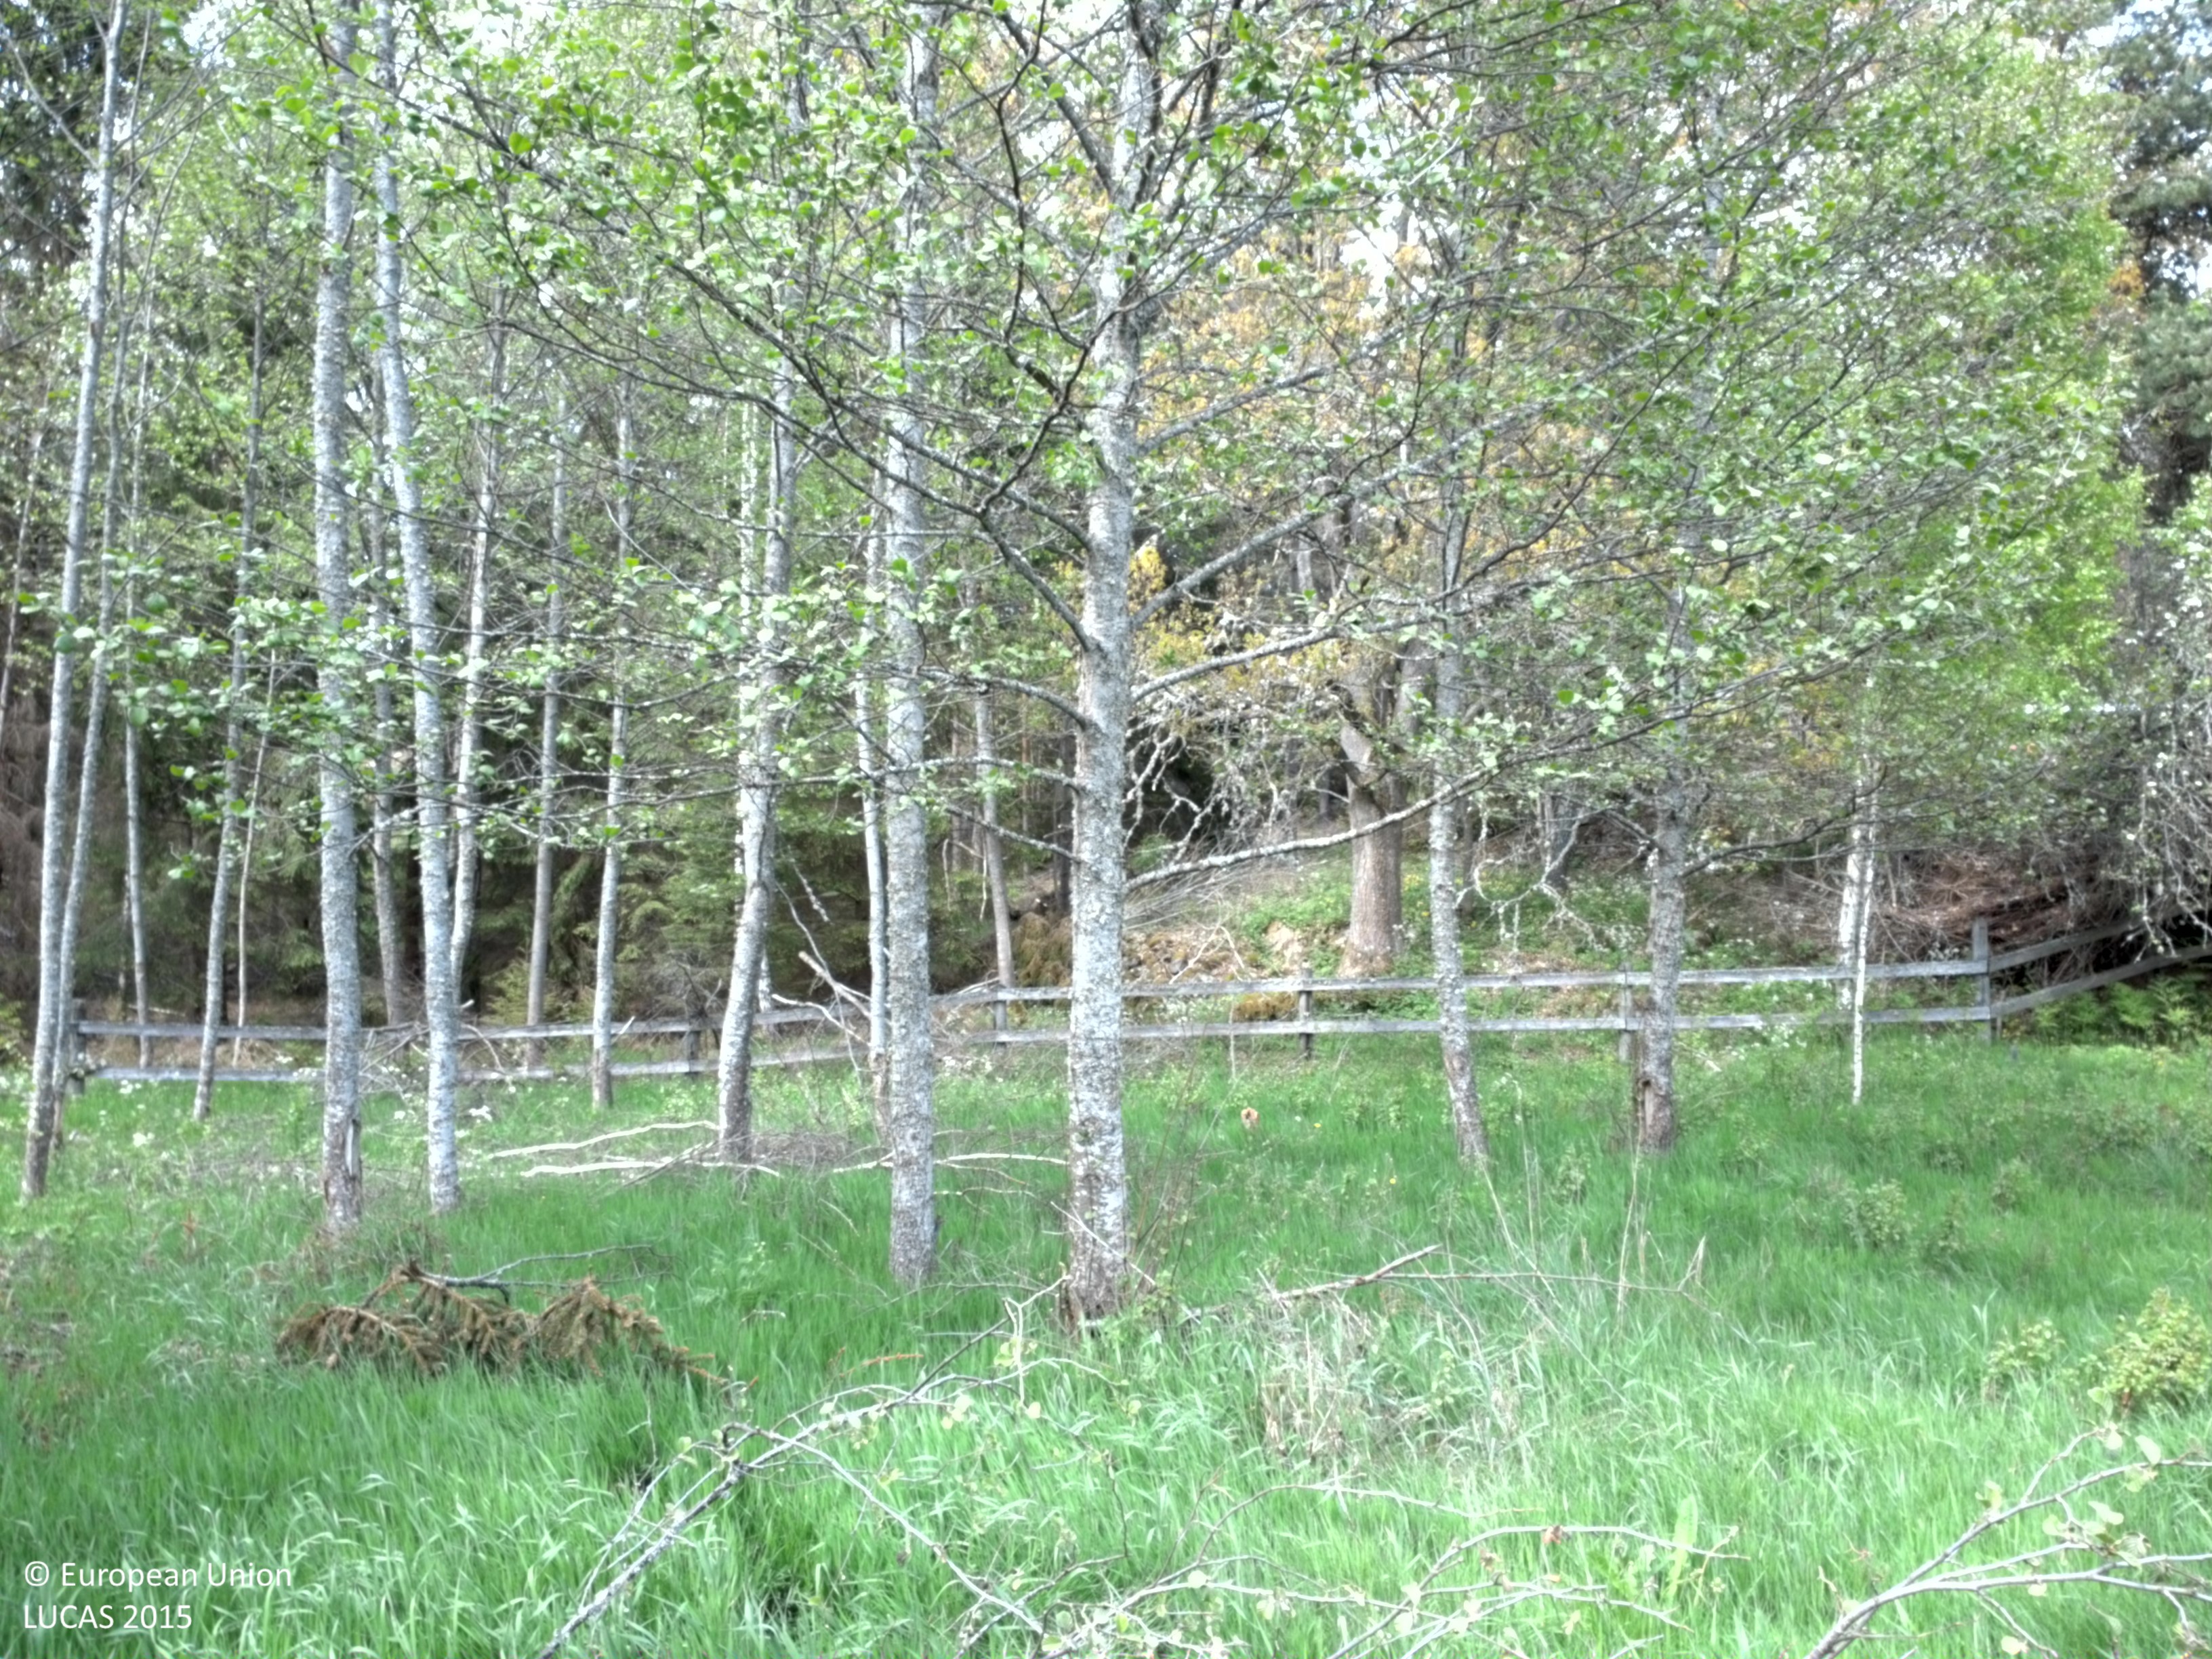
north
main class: Grassland
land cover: Grassland with sparse tree/shrub cover
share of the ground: > 75 %
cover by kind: herbaceous plants 95 %, coniferous forest trees 5 %
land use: Agriculture (excluding fallow land and kitchen gardens)
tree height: > 5 m
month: May
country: SE
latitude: 57.4049
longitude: 15.4728
